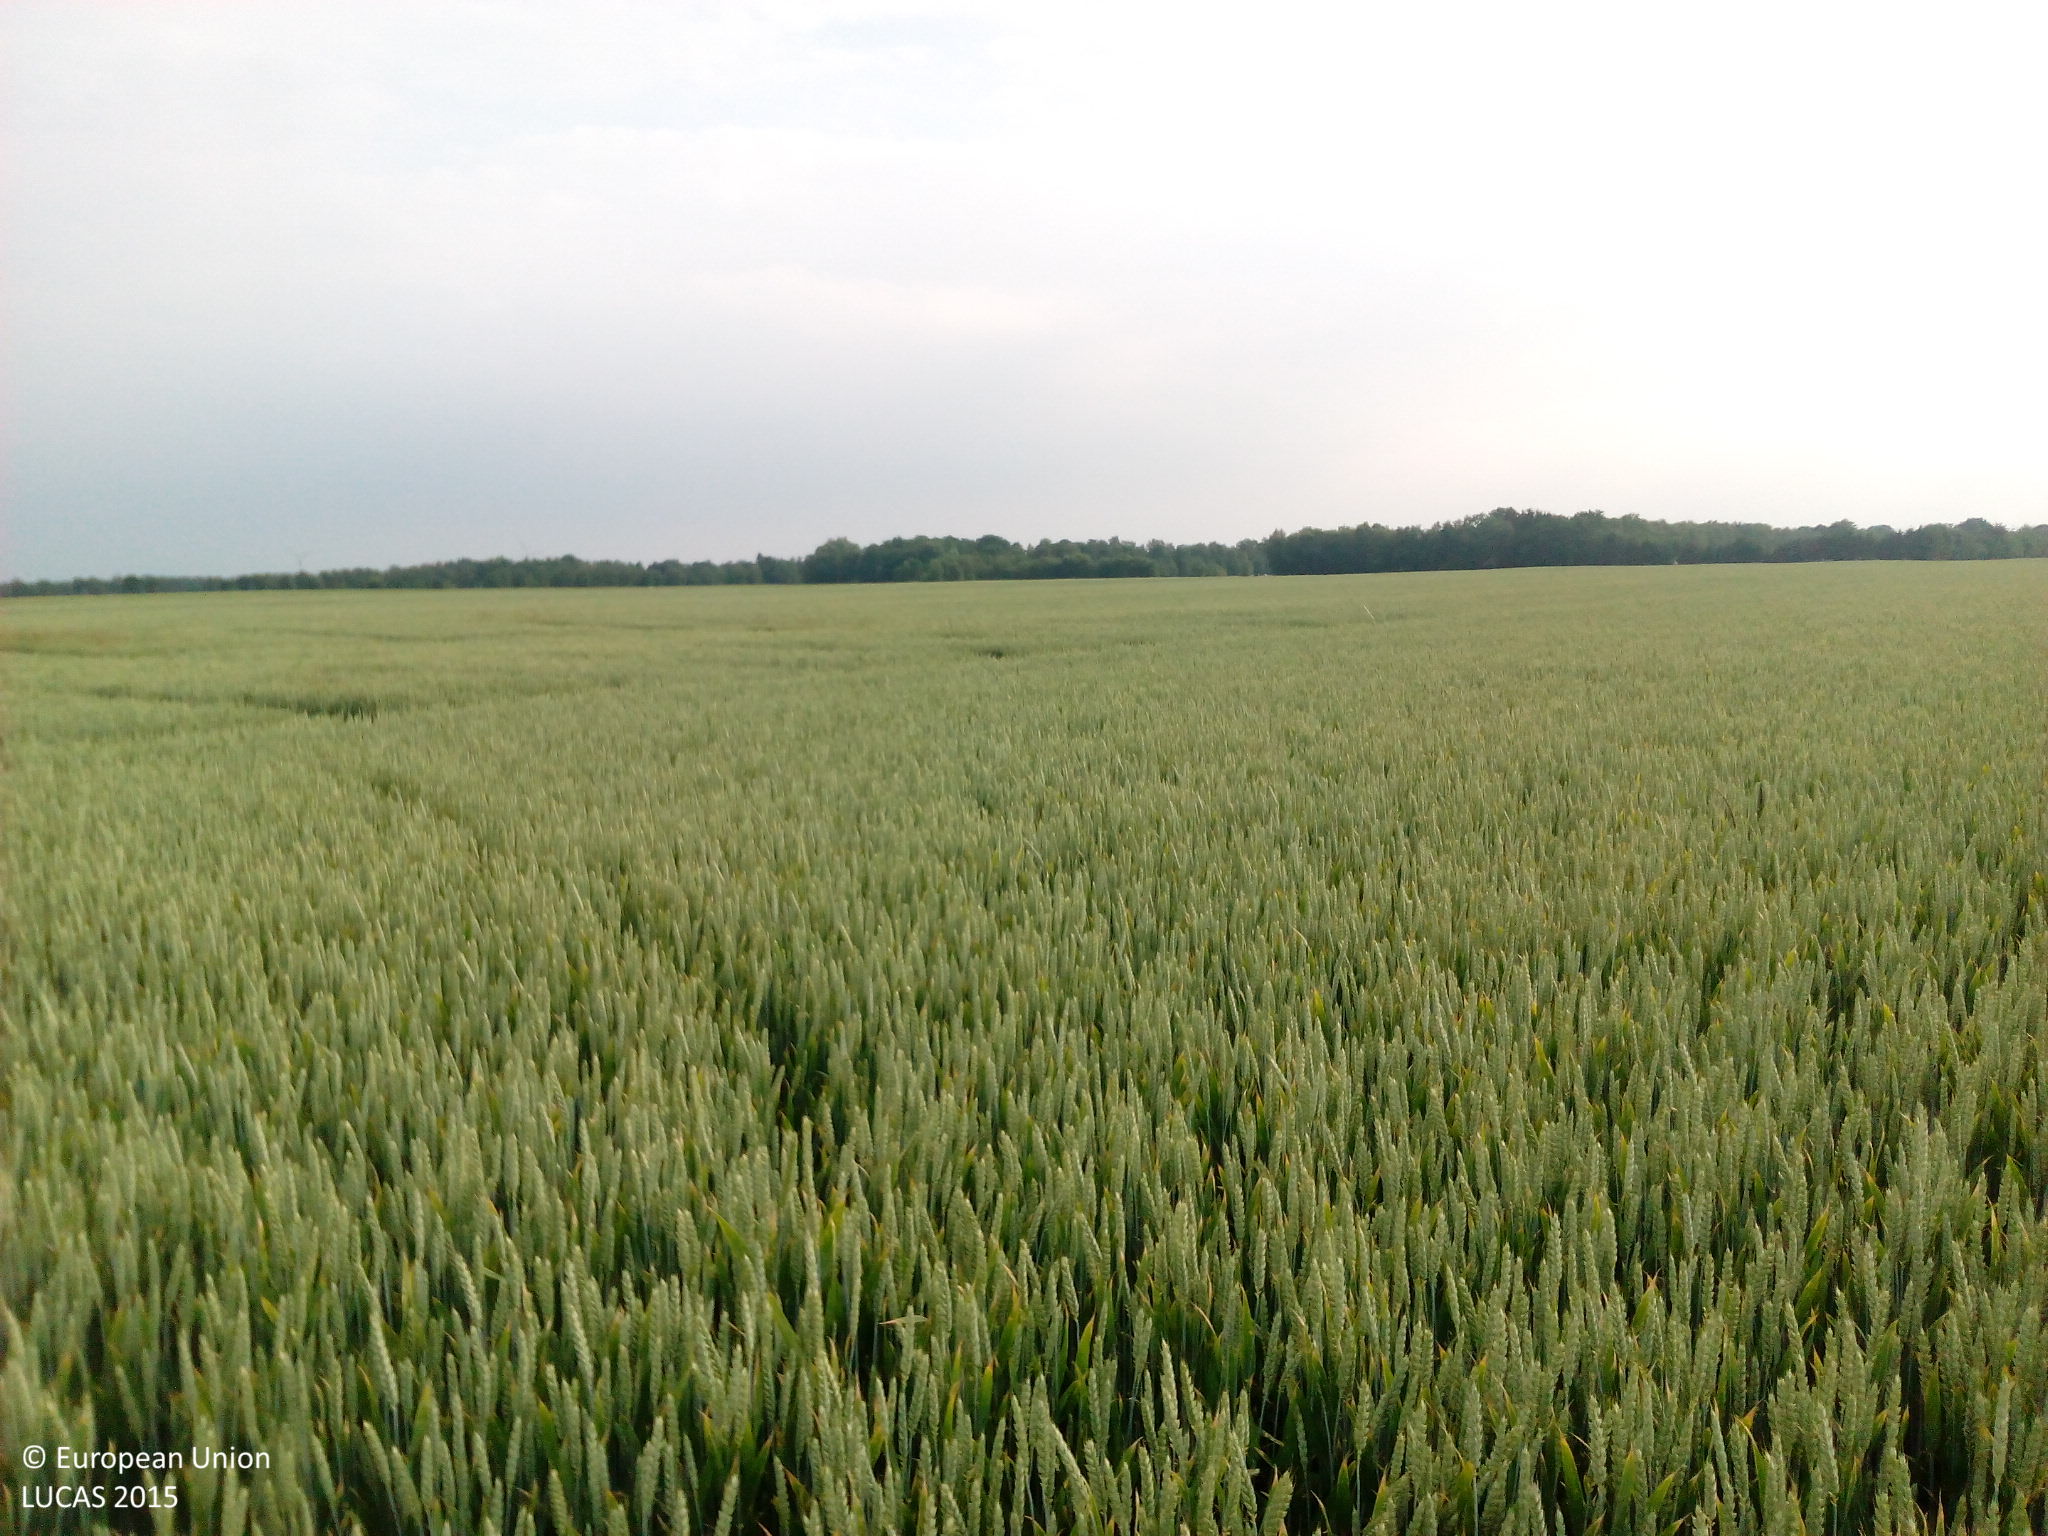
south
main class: Cropland
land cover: Common wheat
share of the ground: > 75 %
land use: Agriculture (excluding fallow land and kitchen gardens)
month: June
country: DE
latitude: 53.7415
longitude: 9.3181
